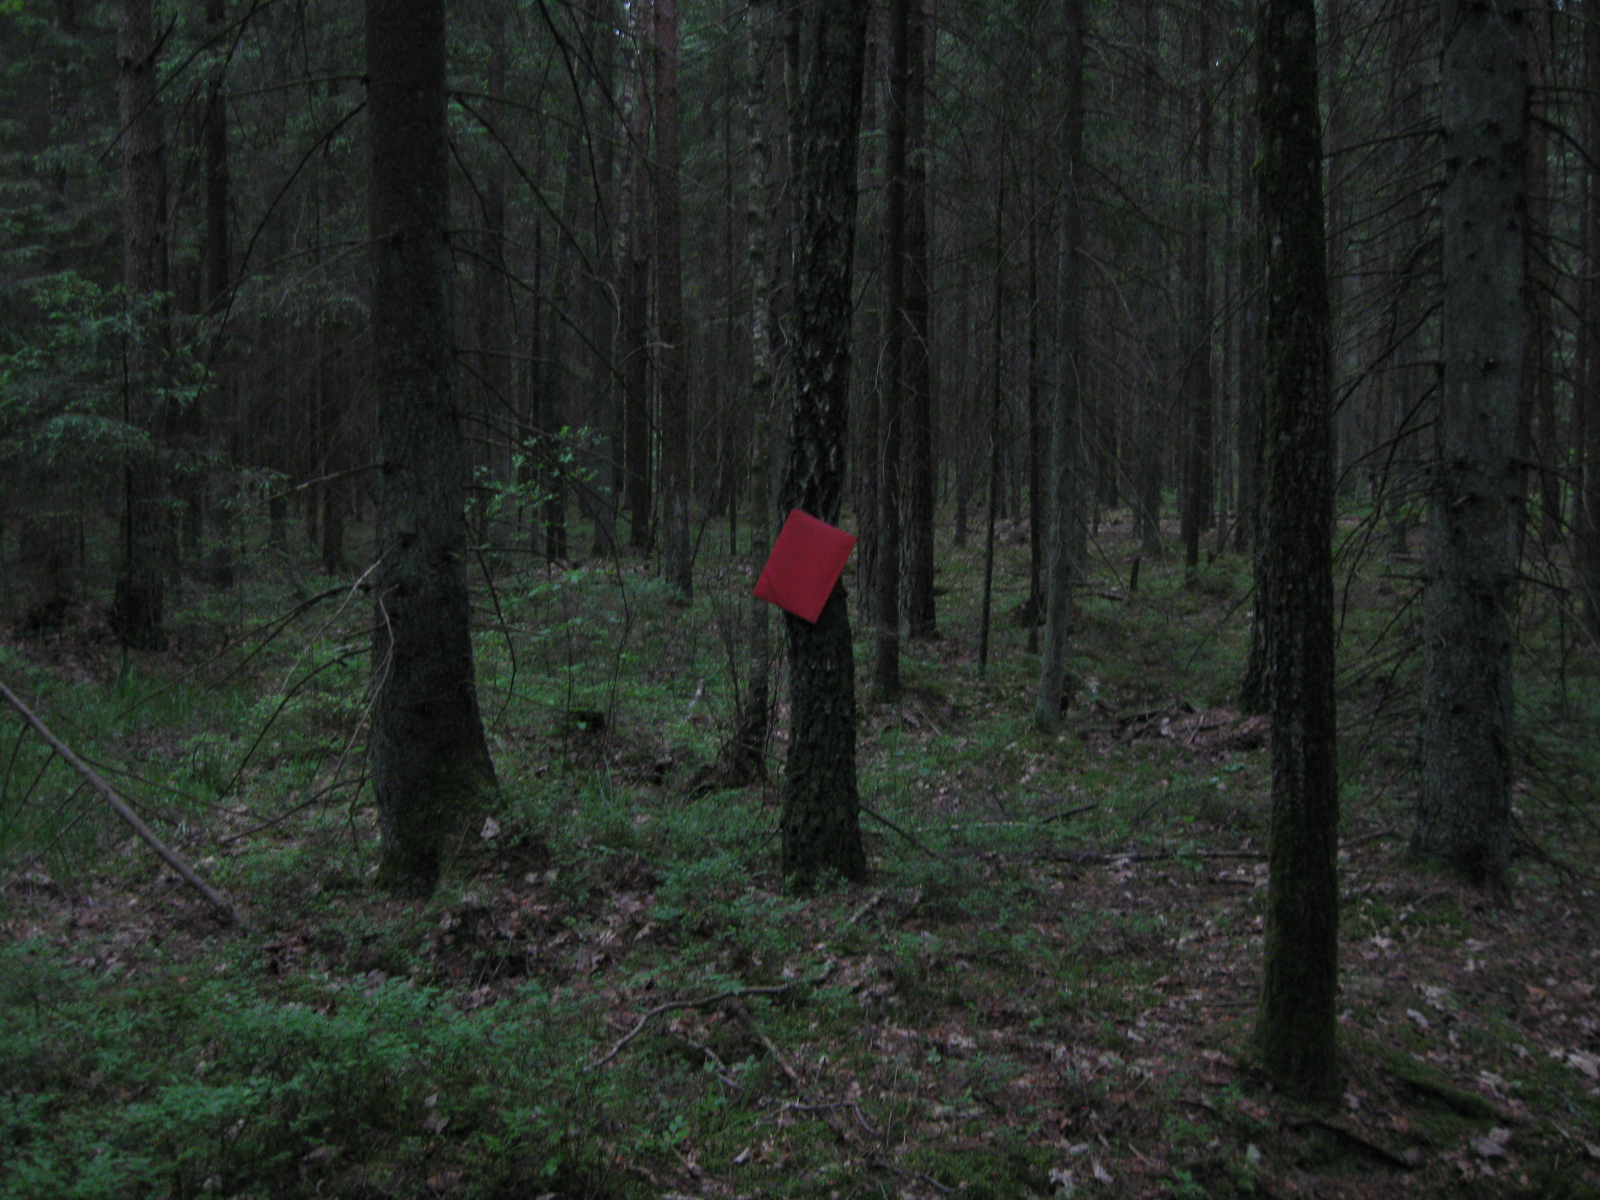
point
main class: Woodland
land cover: Spruce dominated coniferous woodland
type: hemiboreal forest and nemoral coniferous forest and mixed broadleaved-coniferous forest
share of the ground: > 75 %
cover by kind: coniferous forest trees 75 %, broadleaved forest trees 20 %, herbaceous plants 5 %
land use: Forestry
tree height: > 5 m
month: June
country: LT
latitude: 55.0166
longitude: 24.6018
